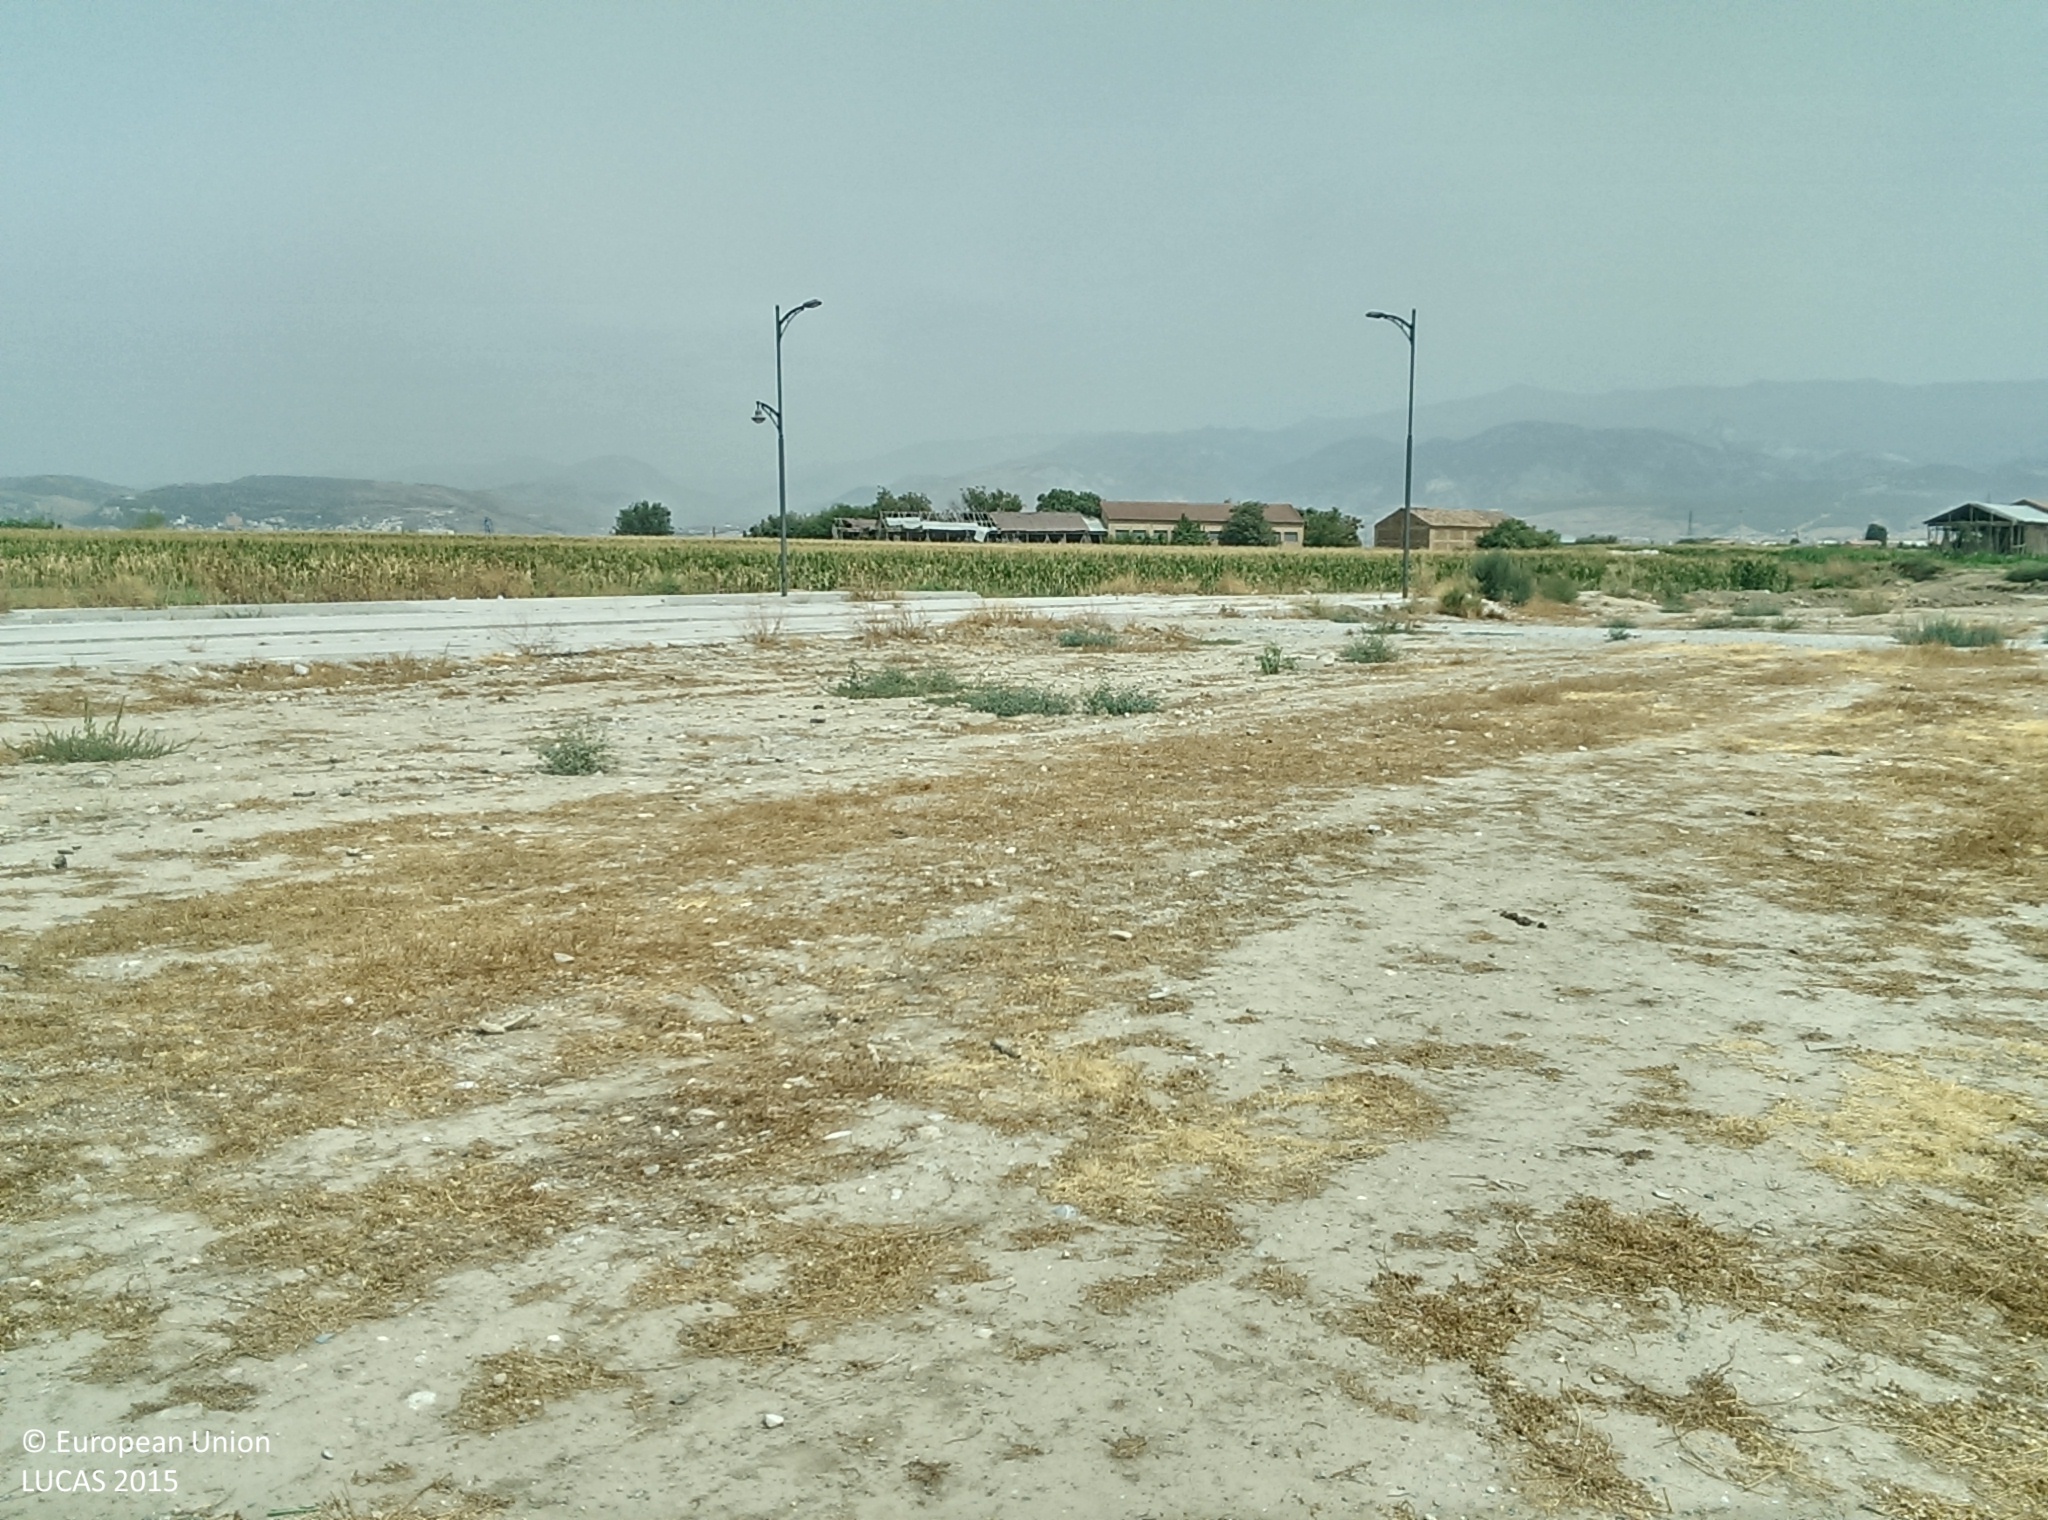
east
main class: Grassland
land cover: Grassland without tree/shrub cover
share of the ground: 10 - 25 %
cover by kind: unconsolidated bare surface 85 %, herbaceous plants 15 %
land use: Residential
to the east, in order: Grassland without tree/shrub cover; Paved roads, cycling and walking lanes; Grassland without tree/shrub cover; Other bare soil; Ditches and canals; Maize; Ditches and canals; Maize; Ditches and canals; Artificial constructions in urban areas; Managed hedges; Tobacco
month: August
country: ES
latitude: 37.1592
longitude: -3.6712
